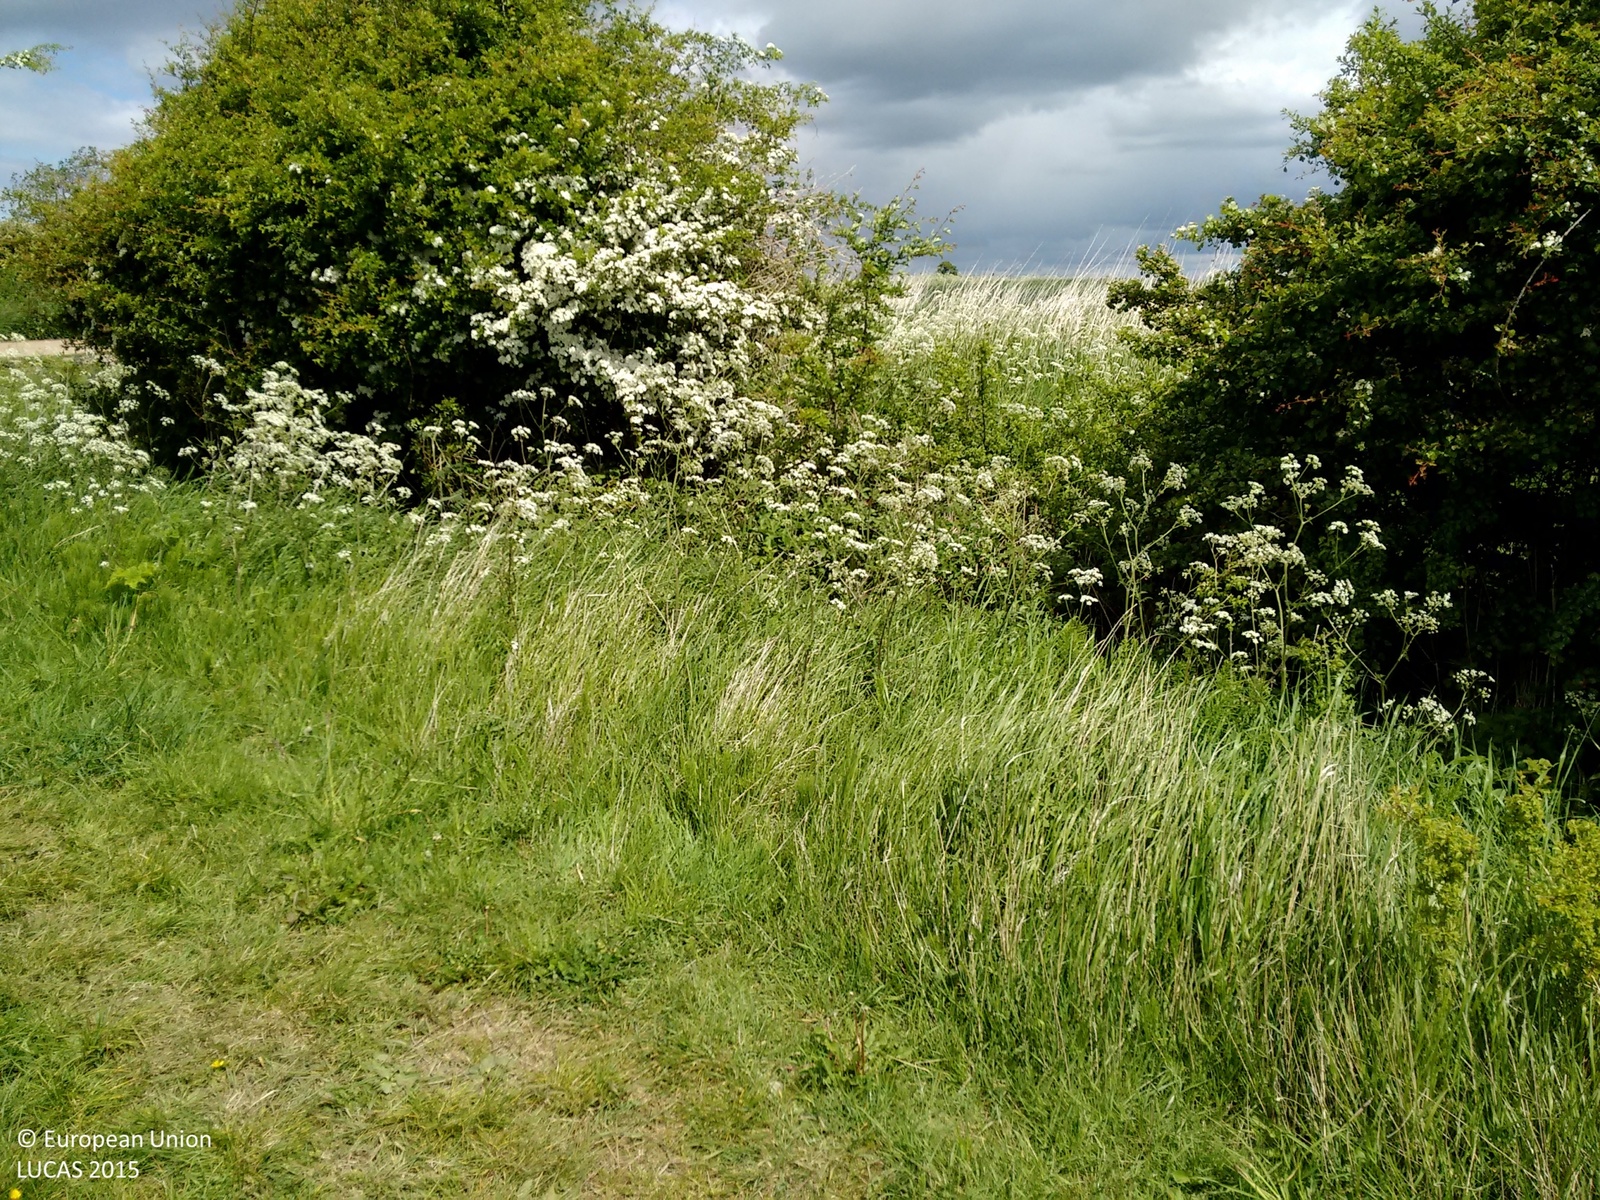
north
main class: Grassland
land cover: Grassland without tree/shrub cover
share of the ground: > 75 %
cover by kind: herbaceous plants 100 %
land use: Agriculture (excluding fallow land and kitchen gardens)
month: May
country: GB
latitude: 52.2113
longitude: -1.3620
